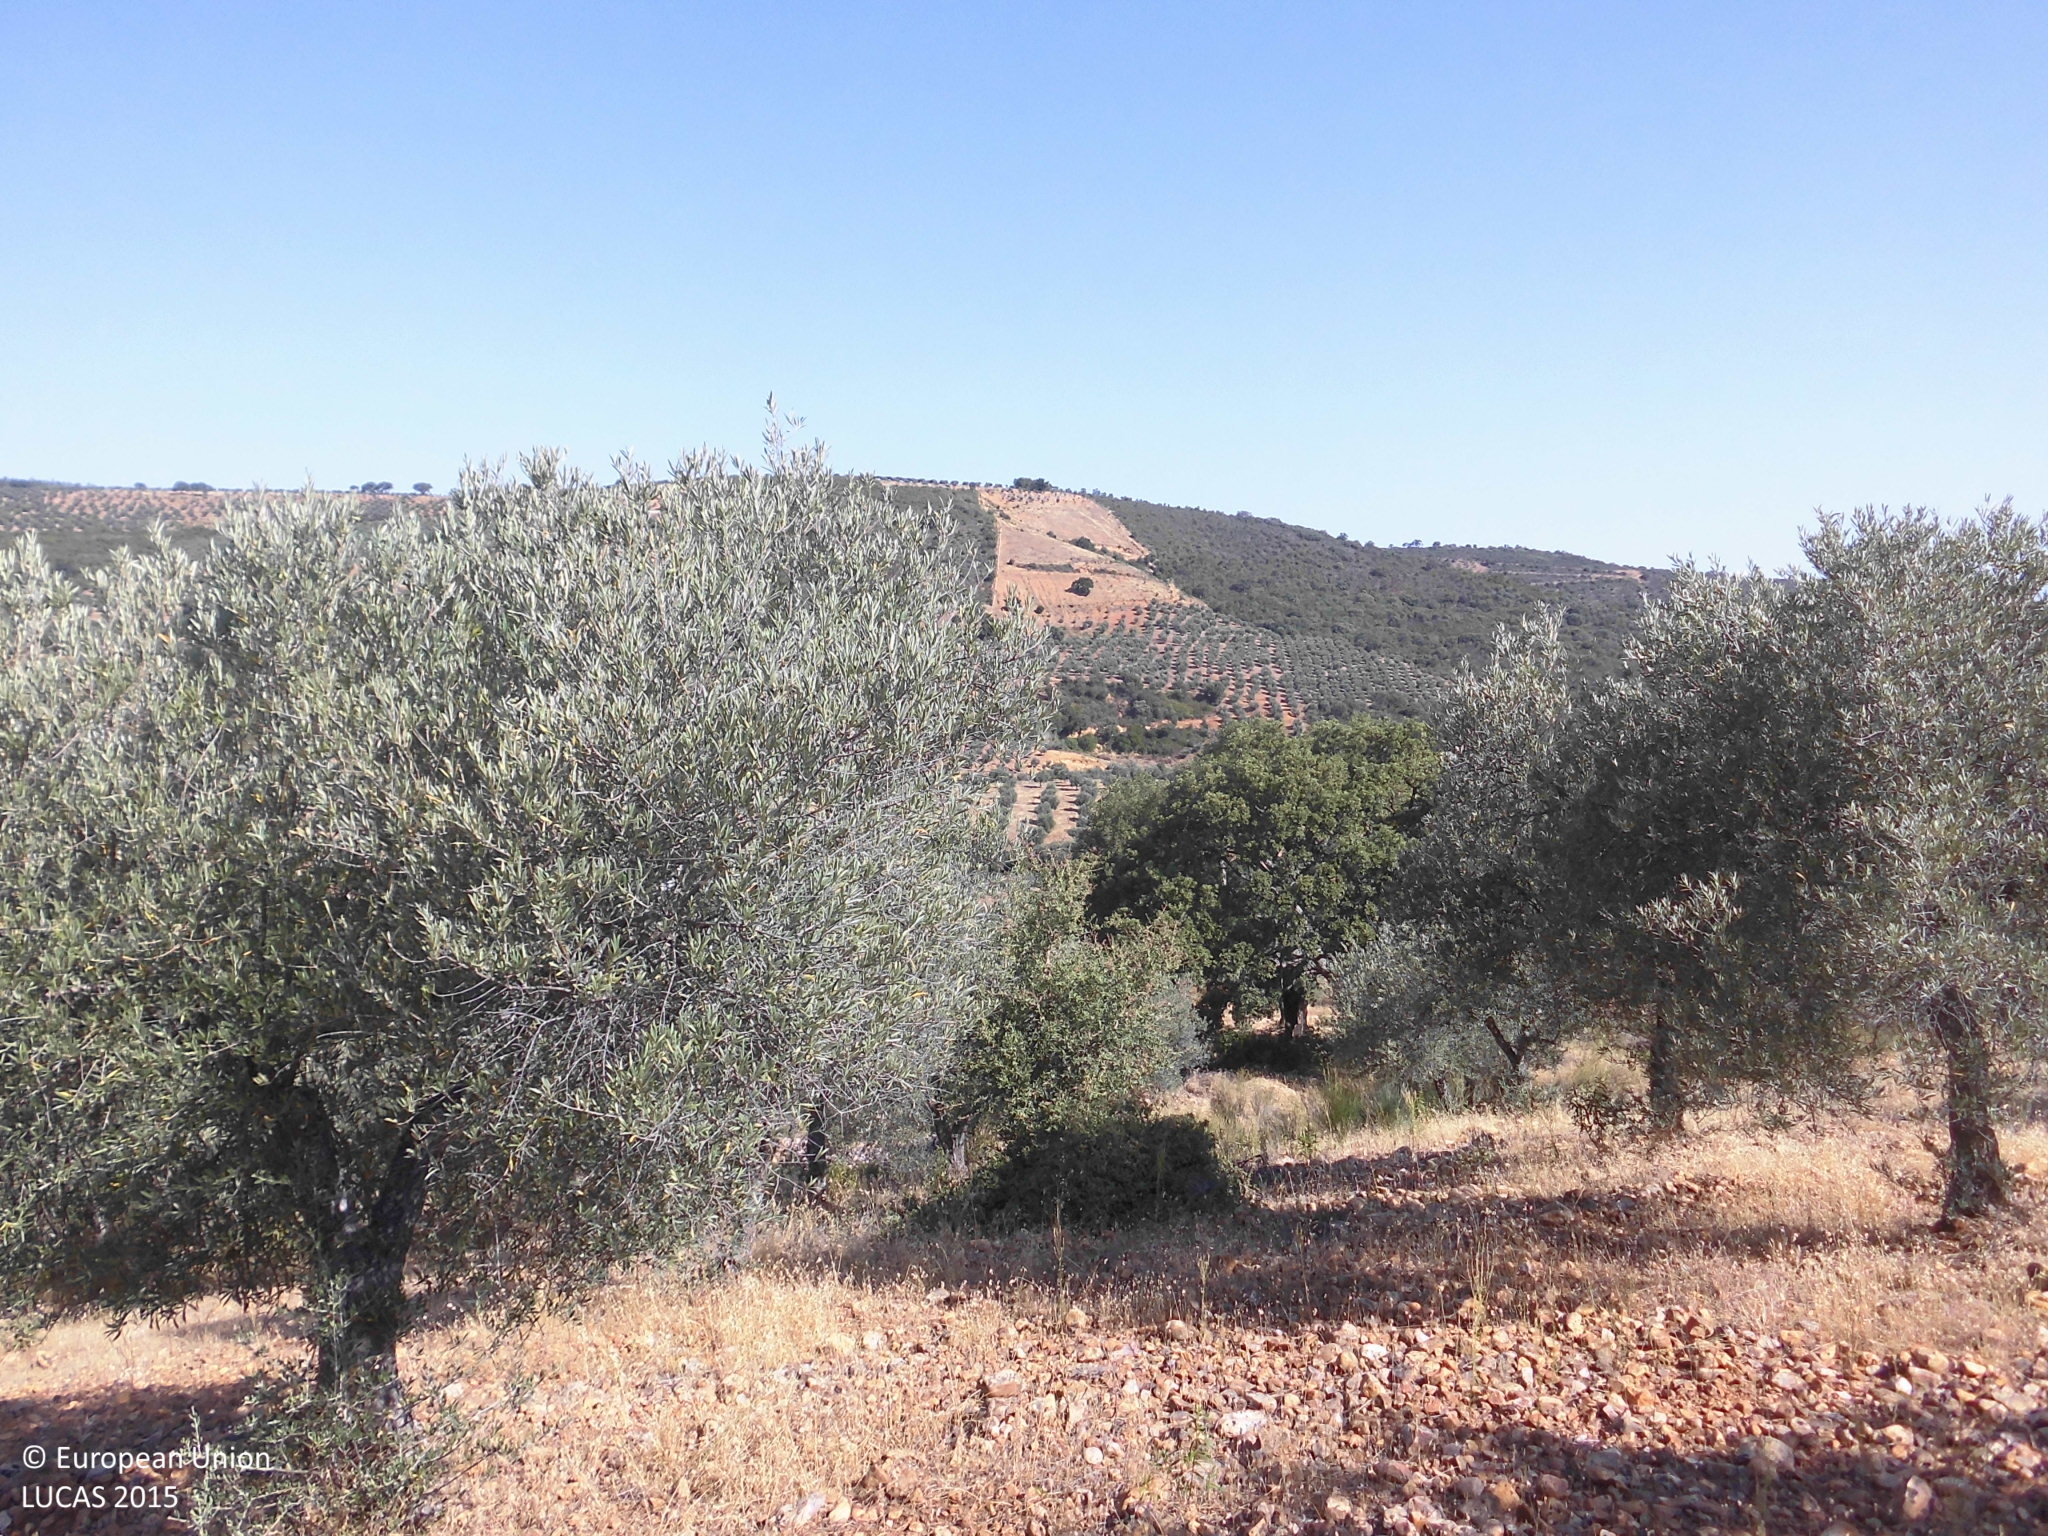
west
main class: Cropland
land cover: Olive groves
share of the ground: 10 - 25 %
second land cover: Other bare soil
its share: > 75 %
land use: Agriculture (excluding fallow land and kitchen gardens)
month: July
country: ES
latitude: 39.6991
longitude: -5.4365
